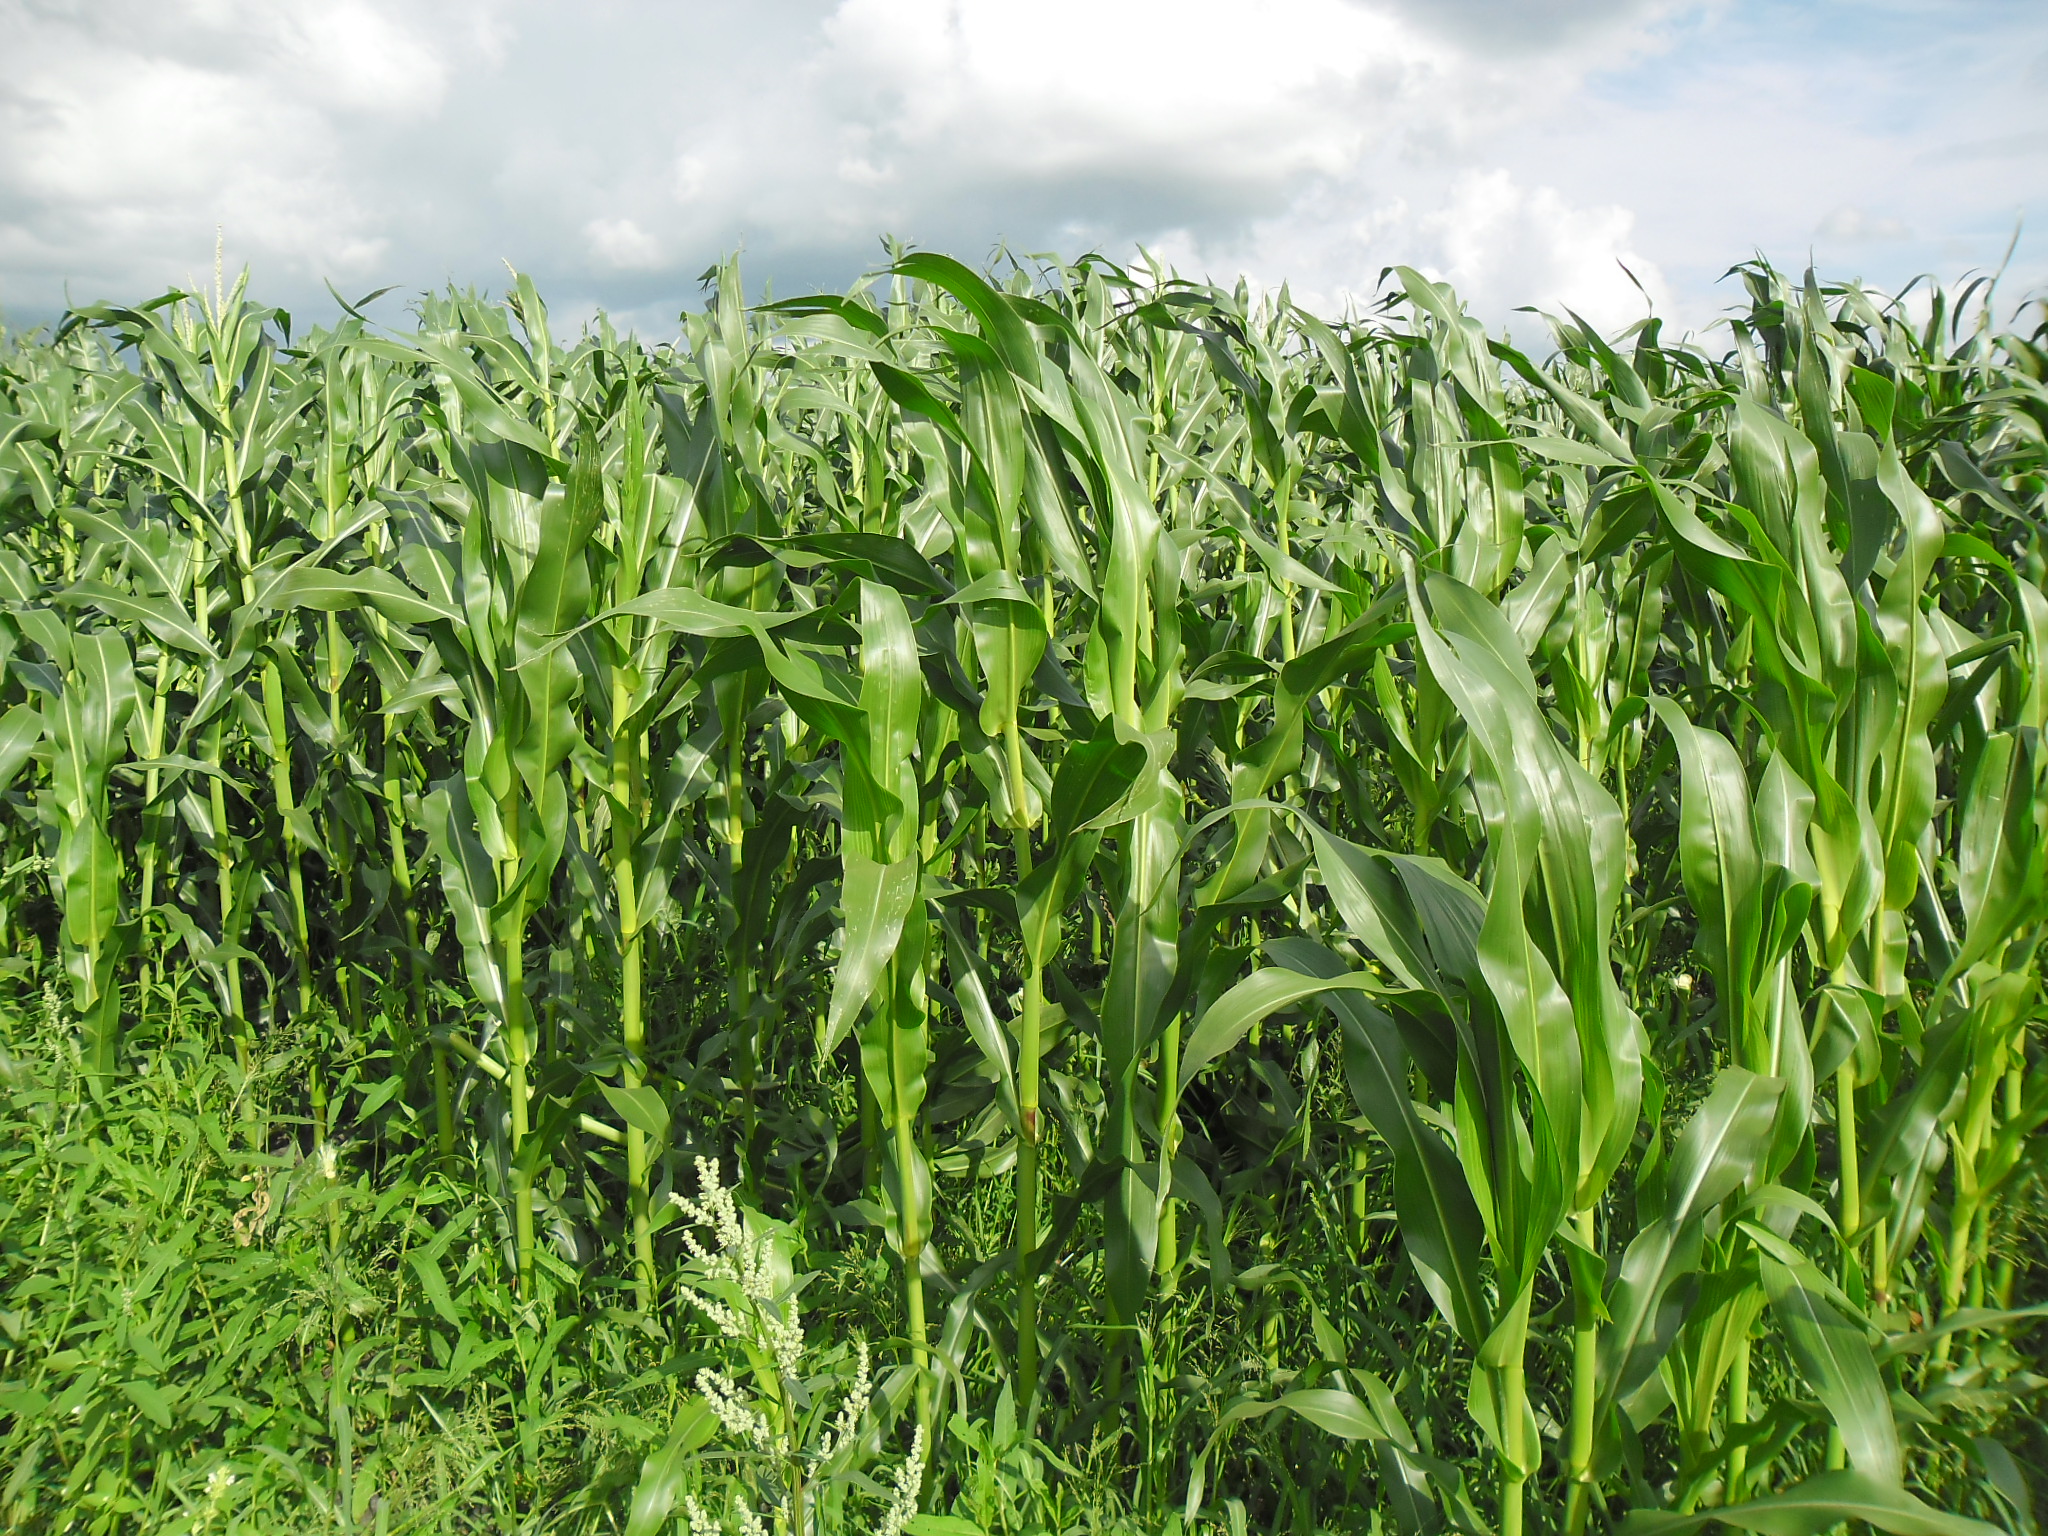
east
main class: Cropland
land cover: Maize
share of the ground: > 75 %
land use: Agriculture (excluding fallow land and kitchen gardens)
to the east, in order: Ditches and canals; Maize; Ditches and canals; Maize; Grassland without tree/shrub cover; Paved roads, cycling and walking lanes; Lines of trees; Fences; Grassland without tree/shrub cover
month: July
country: NL
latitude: 52.6416
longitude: 6.2311
